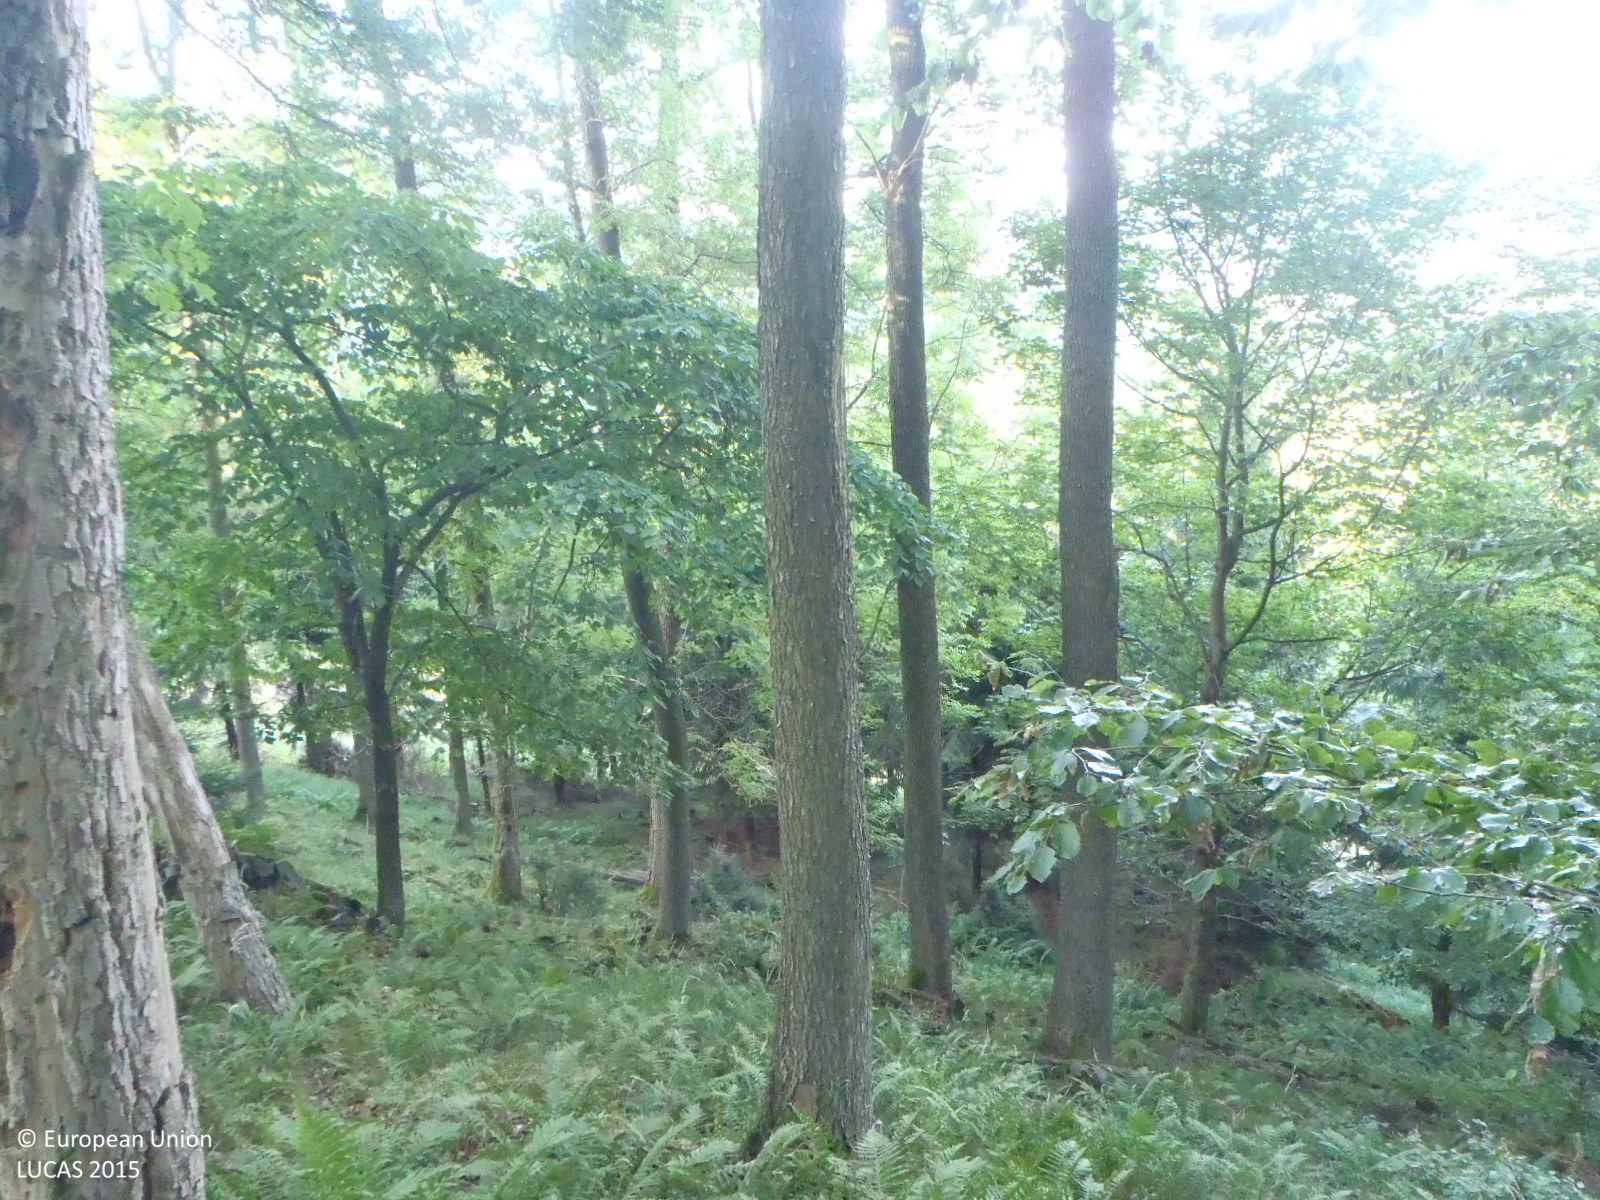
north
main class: Woodland
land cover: Broadleaved woodland
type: beech forest
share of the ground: > 75 %
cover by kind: broadleaved forest trees 95 %, herbaceous plants 5 %
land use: Forestry
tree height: > 5 m
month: August
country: CZ
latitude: 50.7956
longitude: 14.5561
